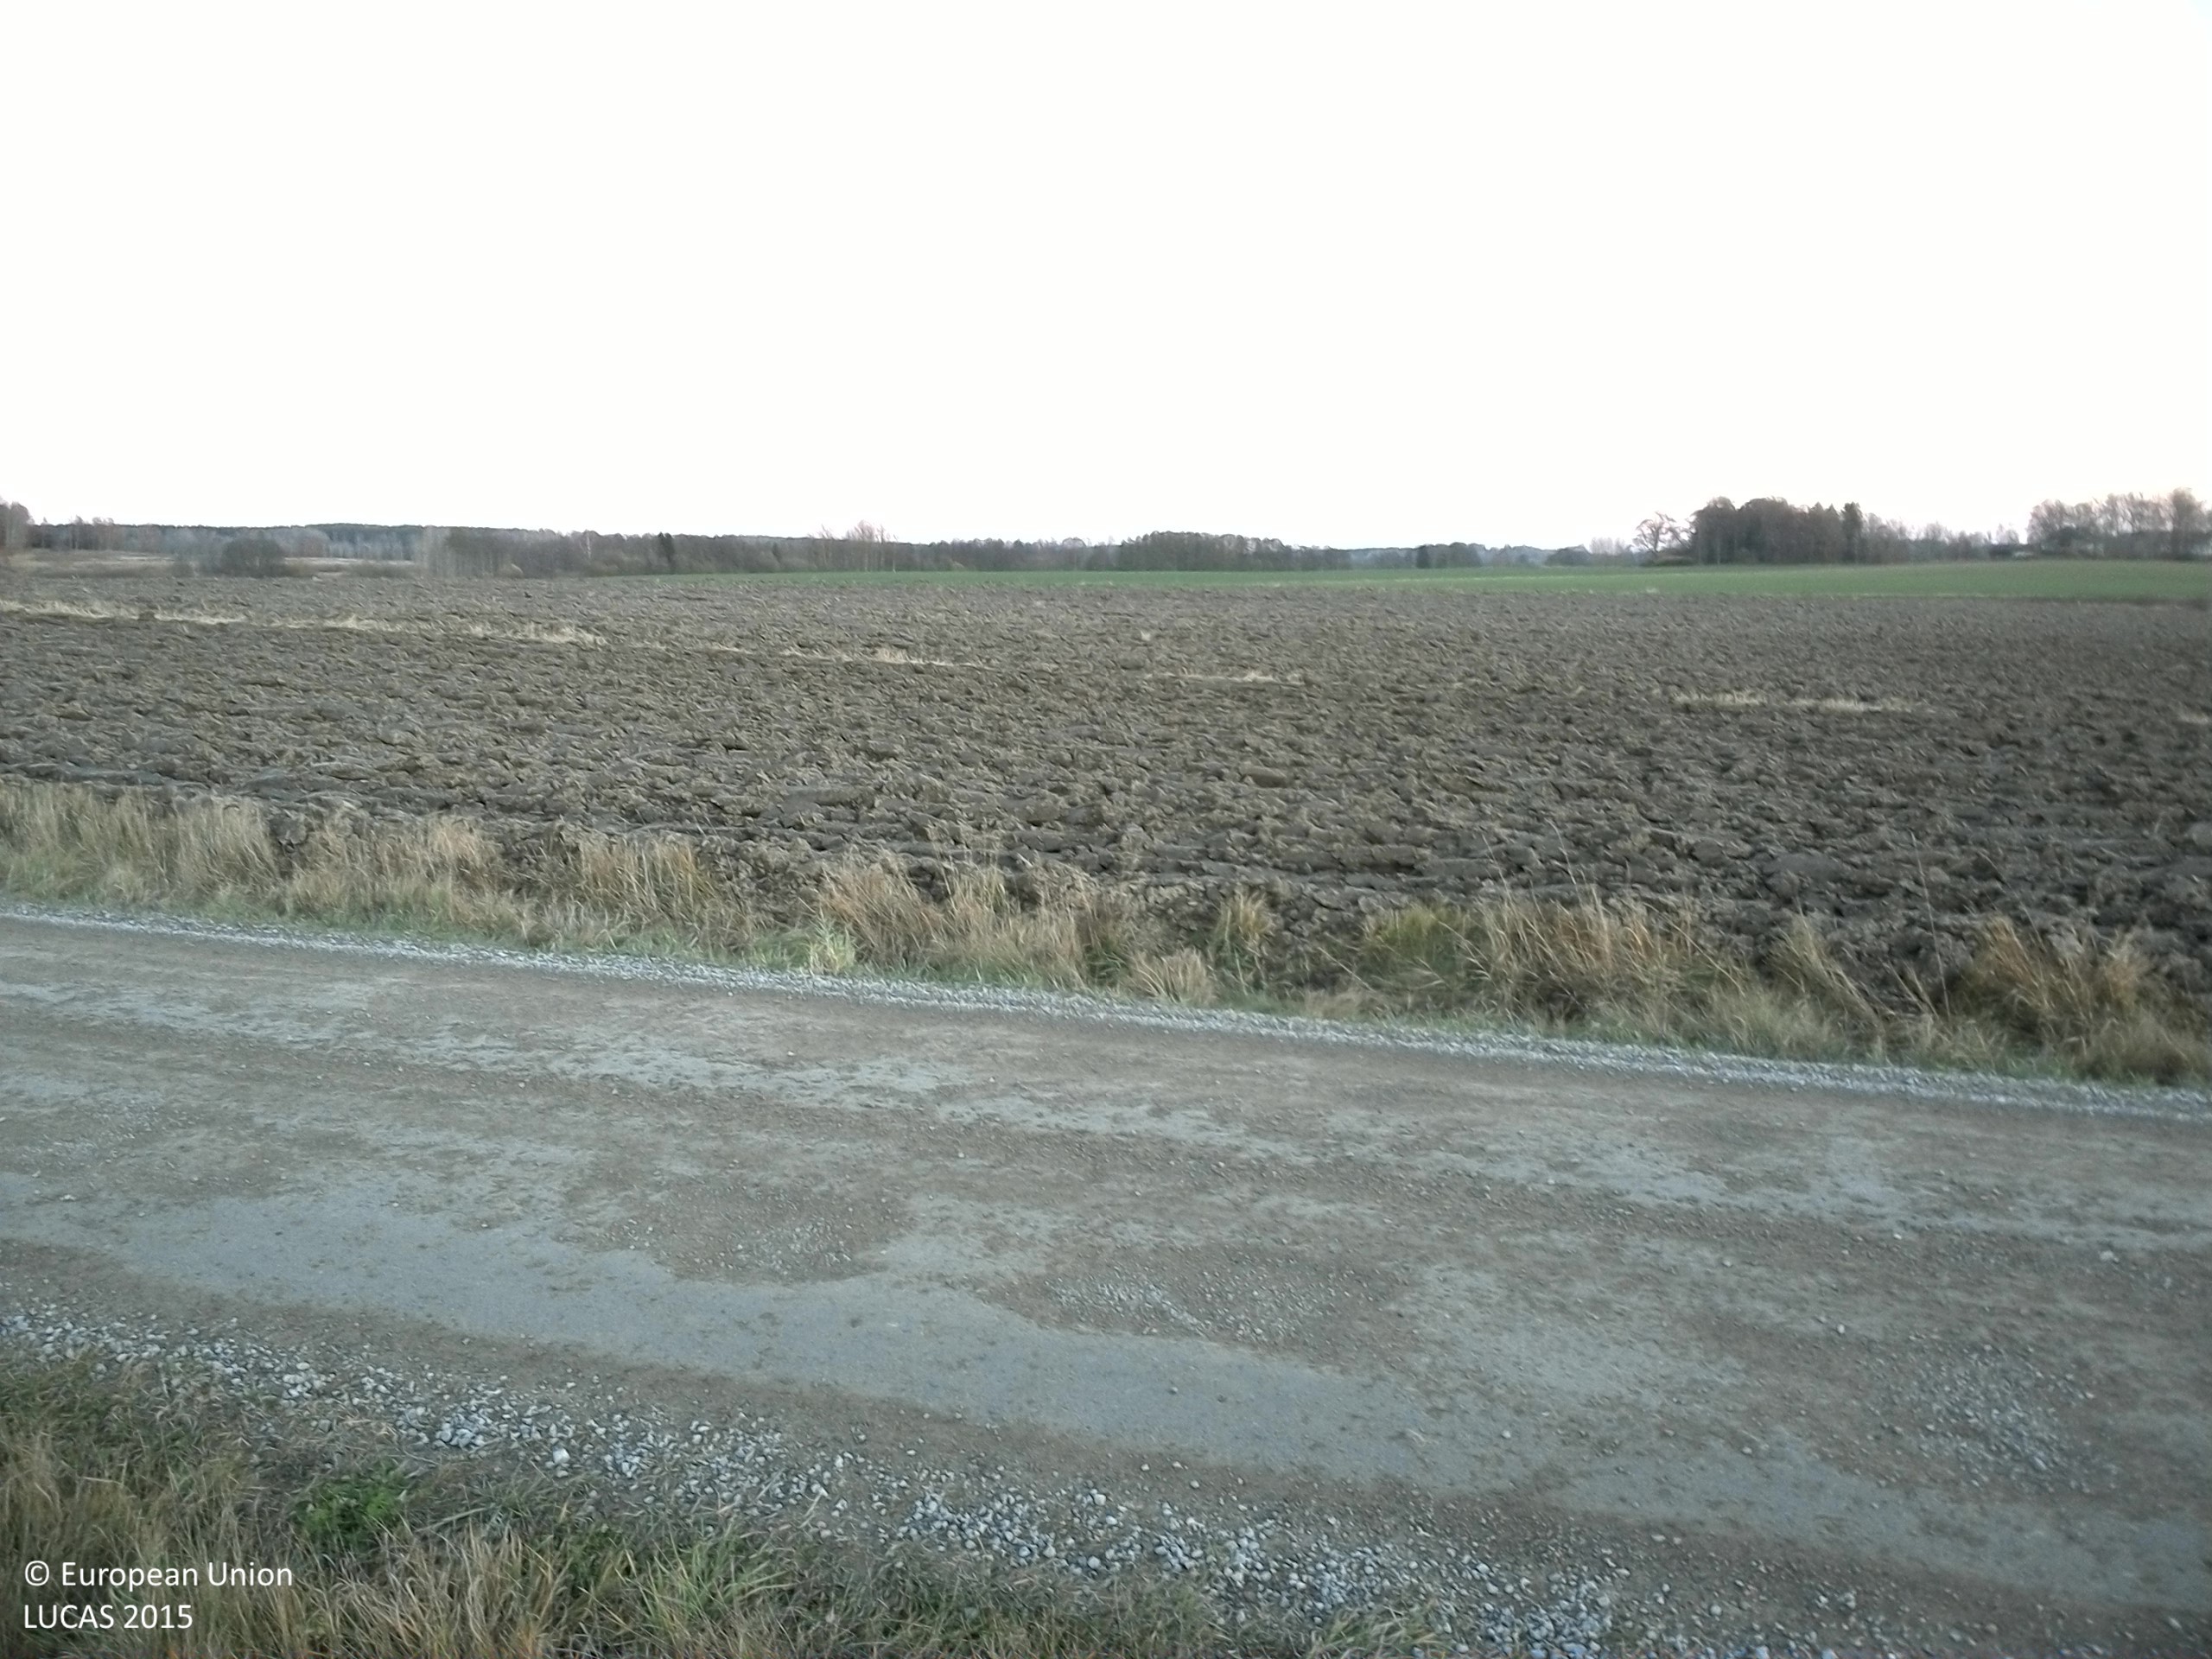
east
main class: Cropland
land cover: Common wheat
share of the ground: > 75 %
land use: Agriculture (excluding fallow land and kitchen gardens)
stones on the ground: < 10 %
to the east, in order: Common wheat; Grass margins; Ditches and canals; Paved roads, cycling and walking lanes; Ditches and canals; Grass margins; Other bare soil
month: November
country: SE
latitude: 58.8383
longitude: 16.8745
